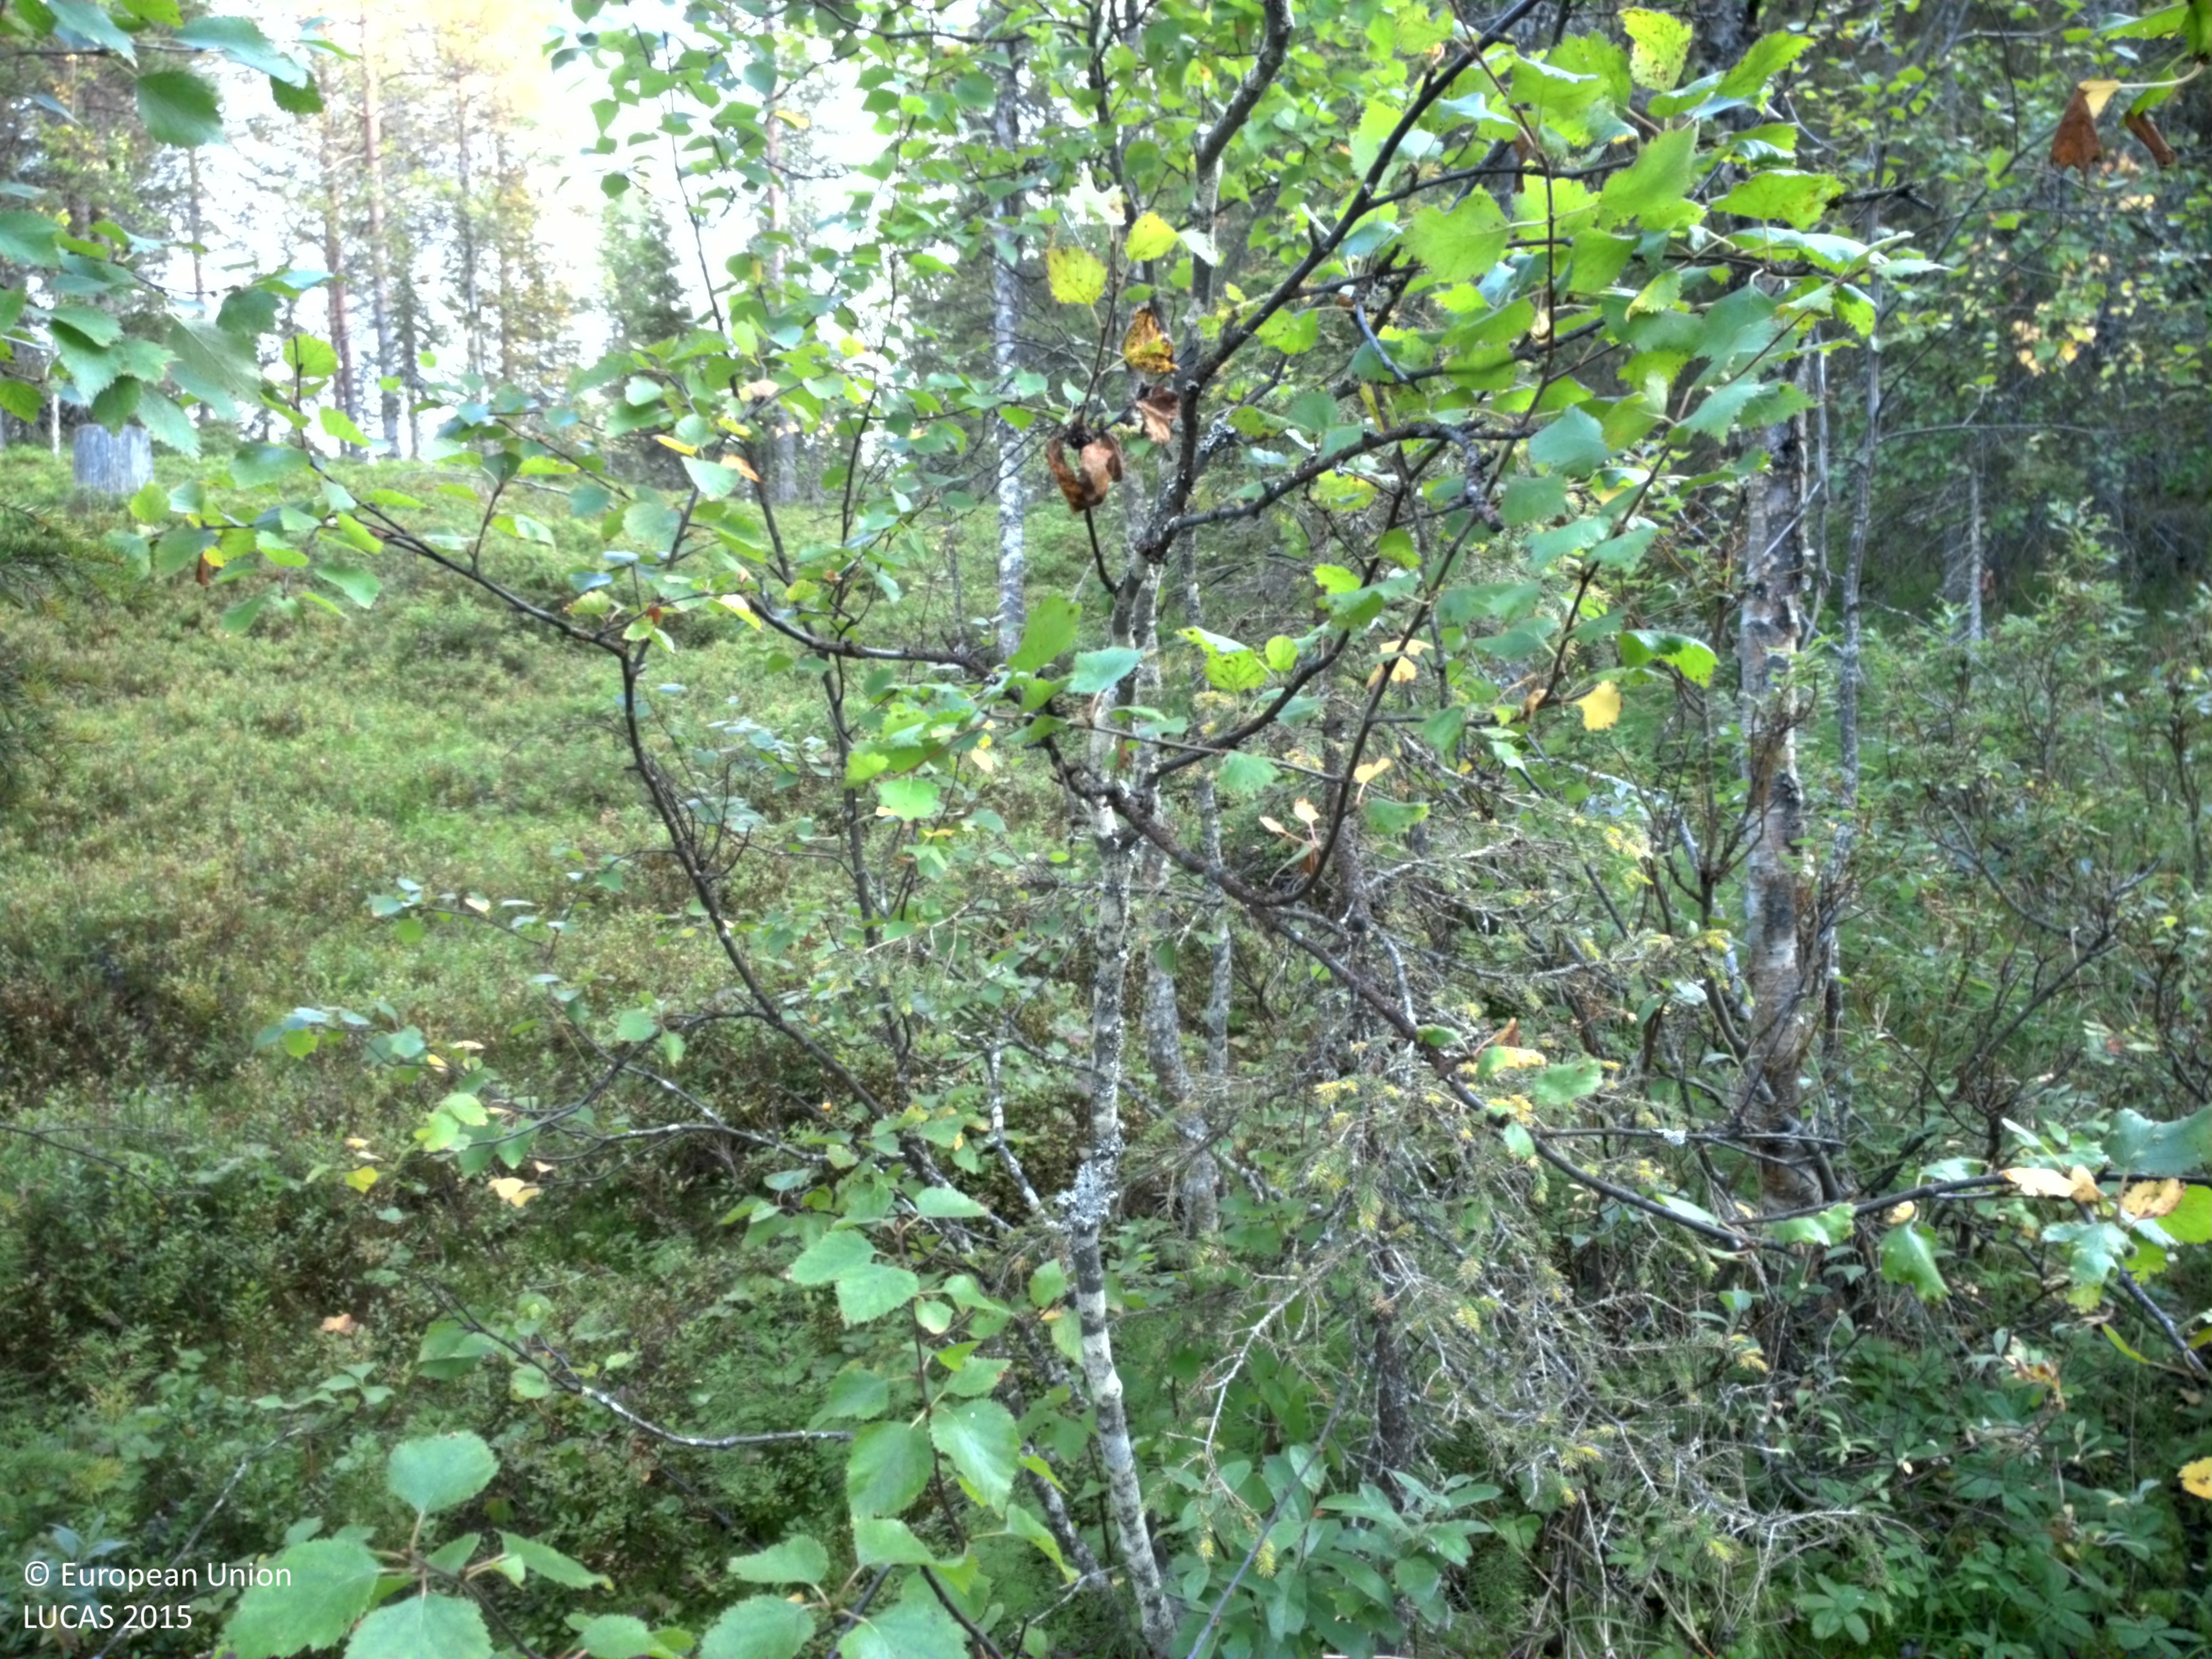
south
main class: Woodland
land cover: Spruce dominated mixed woodland
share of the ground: 25 - 50 %
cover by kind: shrubs 40 %, broadleaved forest trees 25 %, coniferous forest trees 20 %, lichens and mosses 10 %
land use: Forestry
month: August
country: SE
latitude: 66.6086
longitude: 20.7685
